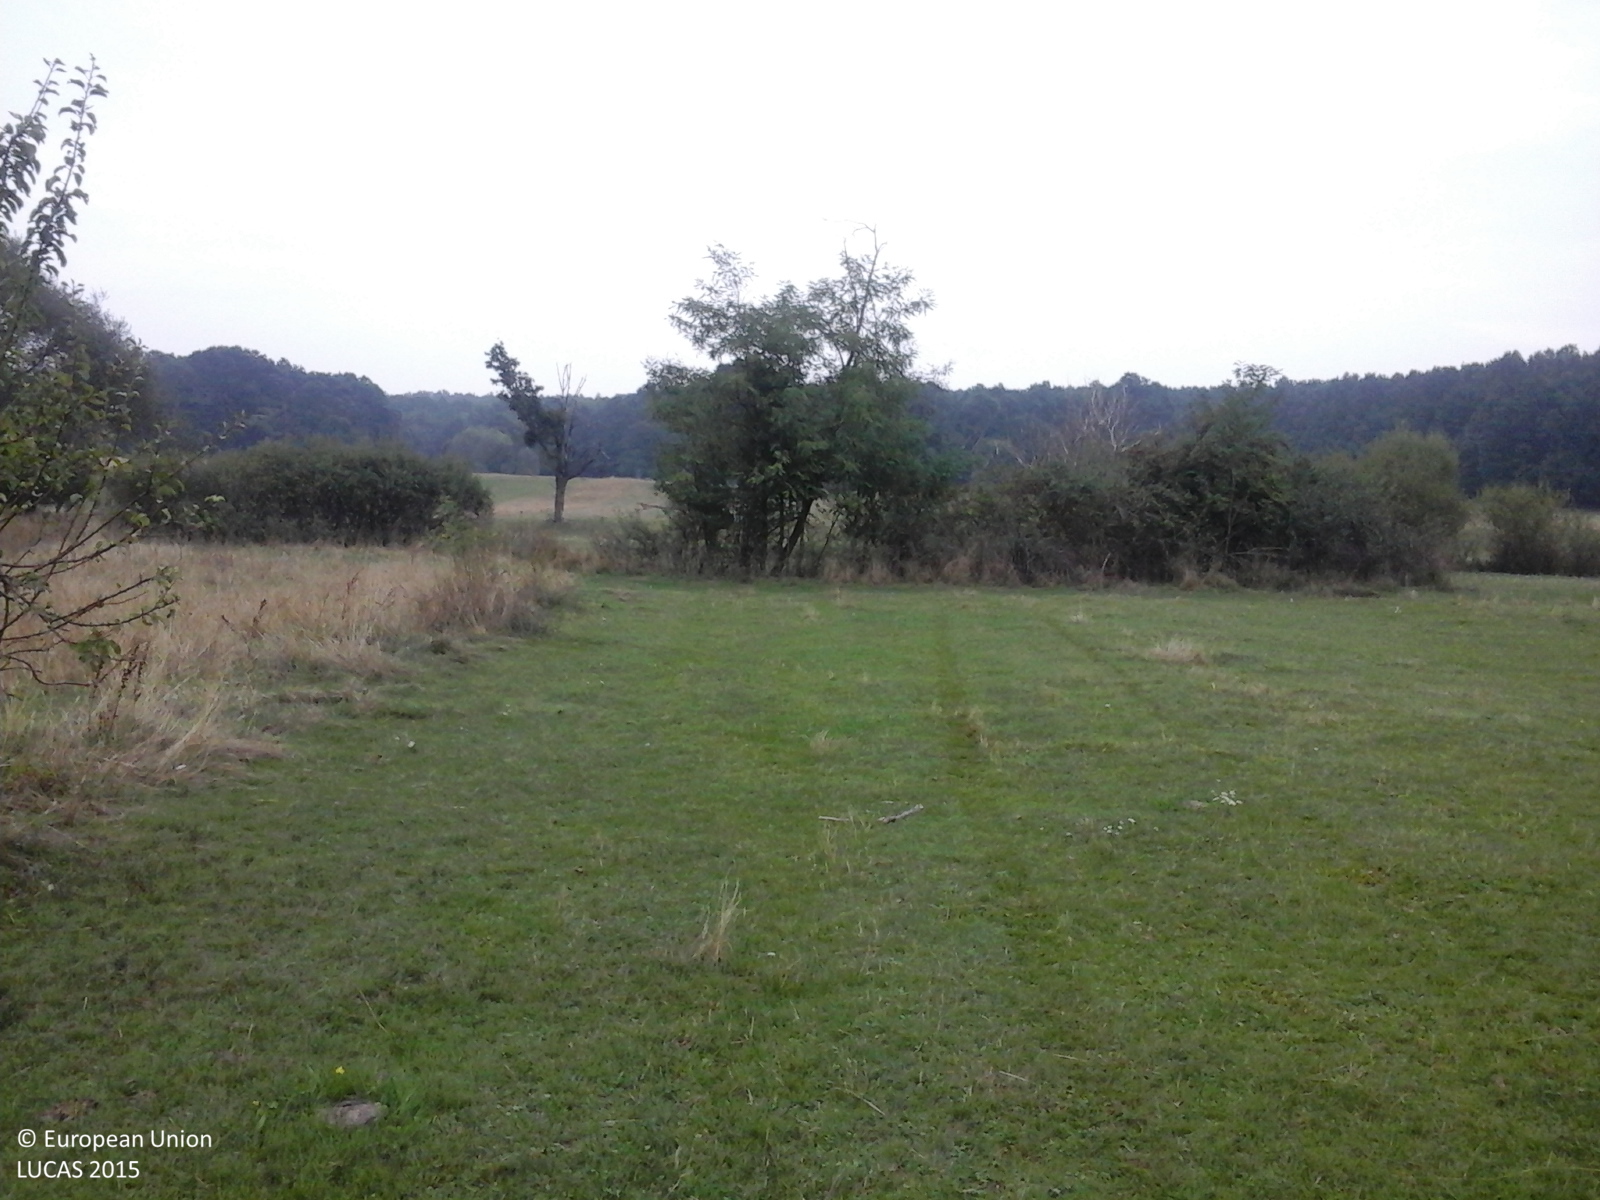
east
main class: Grassland
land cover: Grassland without tree/shrub cover
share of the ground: > 75 %
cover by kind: herbaceous plants 100 %
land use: Agriculture (excluding fallow land and kitchen gardens)
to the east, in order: Grassland without tree/shrub cover; Tracks; Shrubland with sparse tree cover; Grassland without tree/shrub cover; Ditches and canals; Grassland without tree/shrub cover; Single bushes/trees; Grassland without tree/shrub cover; Ditches and canals
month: September
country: RO
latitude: 45.1373
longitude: 23.2667
